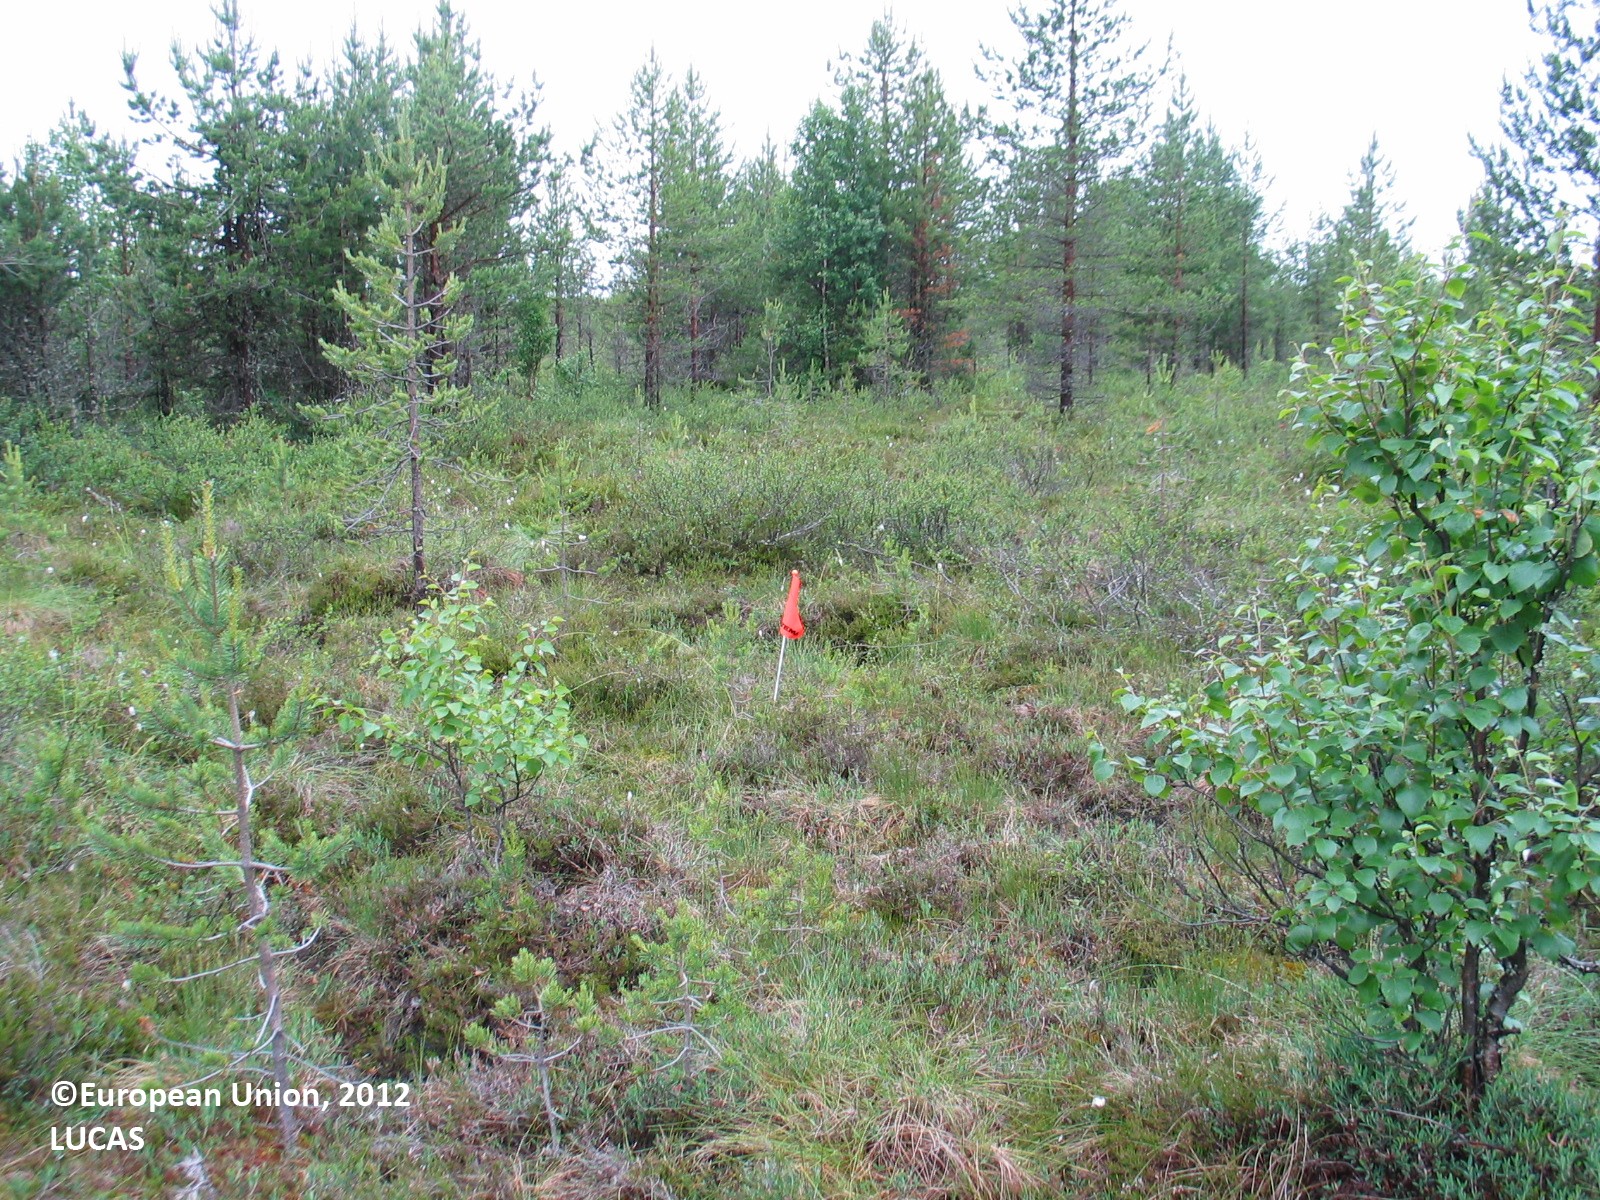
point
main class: Woodland
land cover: Pine dominated coniferous woodland
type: mire and swamp forests
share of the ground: 10 - 25 %
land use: Semi-natural and natural areas not in use
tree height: < 5 m
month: July
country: FI
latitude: 66.0229
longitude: 25.0349
